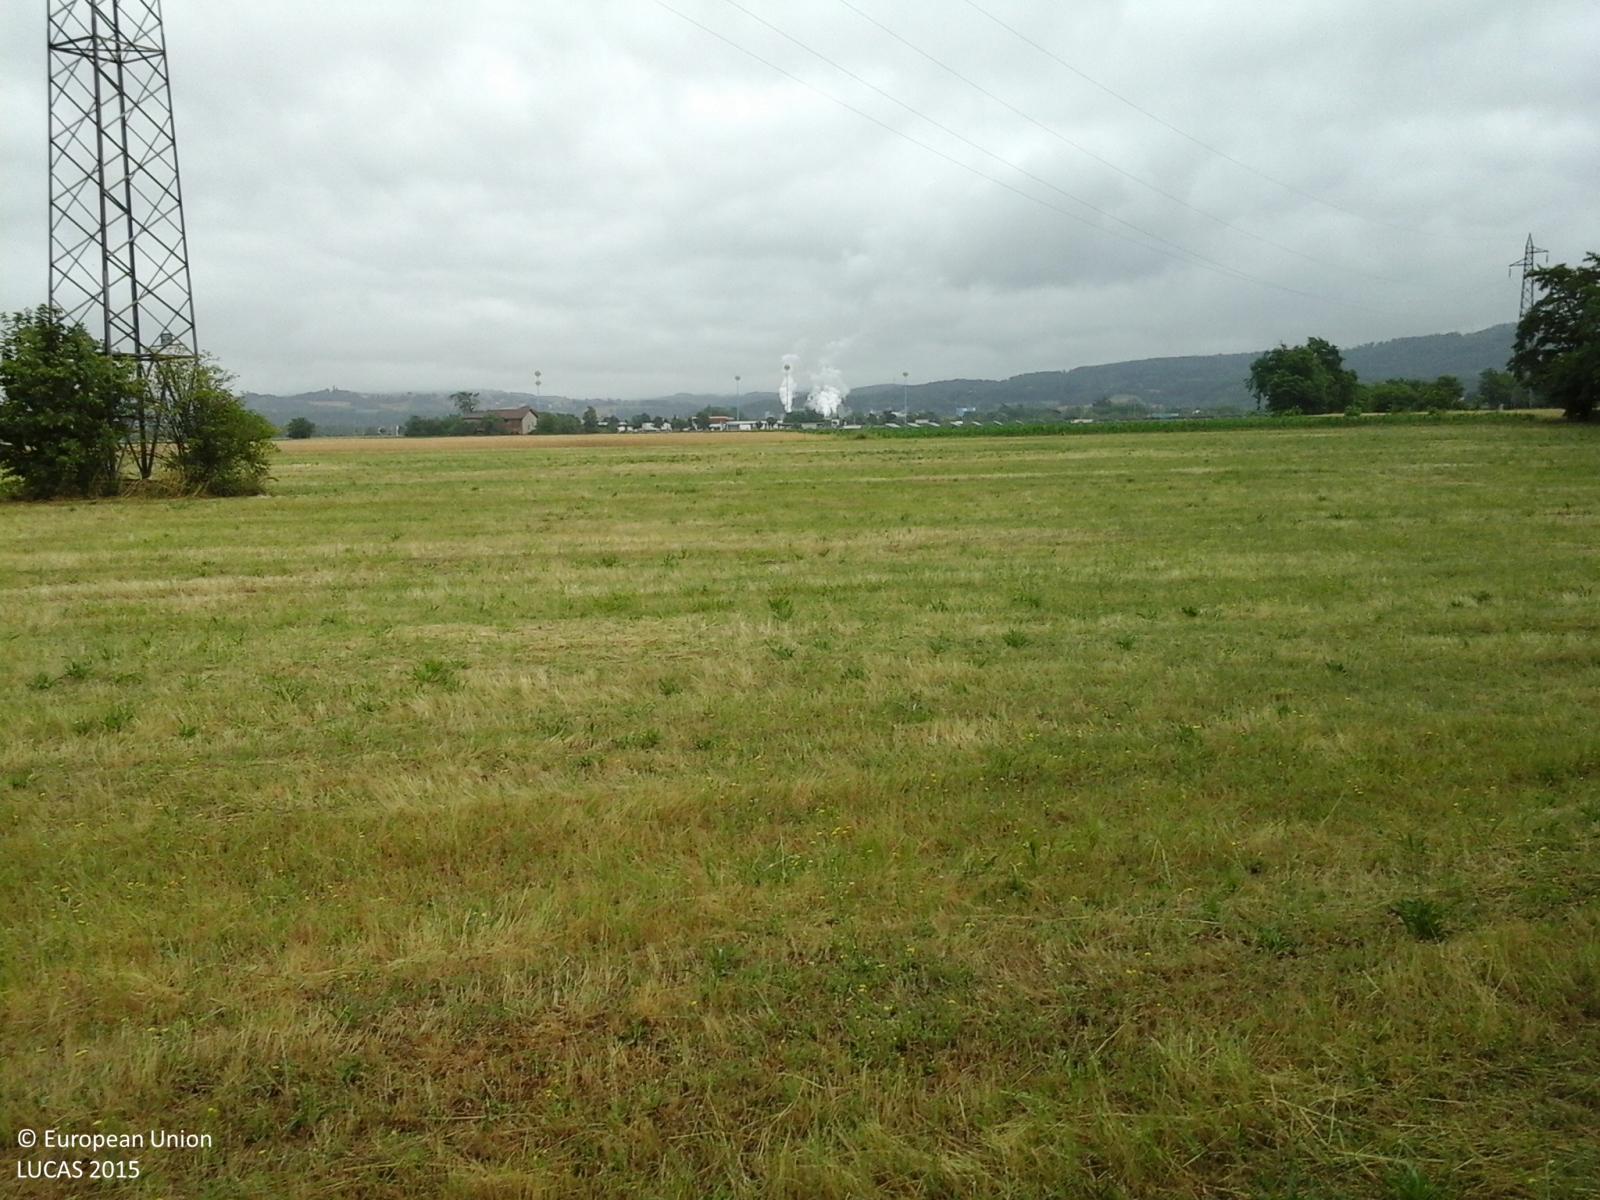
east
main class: Grassland
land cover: Spontaneously vegetated surfaces
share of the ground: > 75 %
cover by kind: herbaceous plants 100 %
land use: Agriculture (excluding fallow land and kitchen gardens)
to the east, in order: Spontaneously vegetated surfaces; Electric lines; Spontaneously vegetated surfaces; Maize
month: June
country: IT
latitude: 44.7587
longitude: 8.8275
